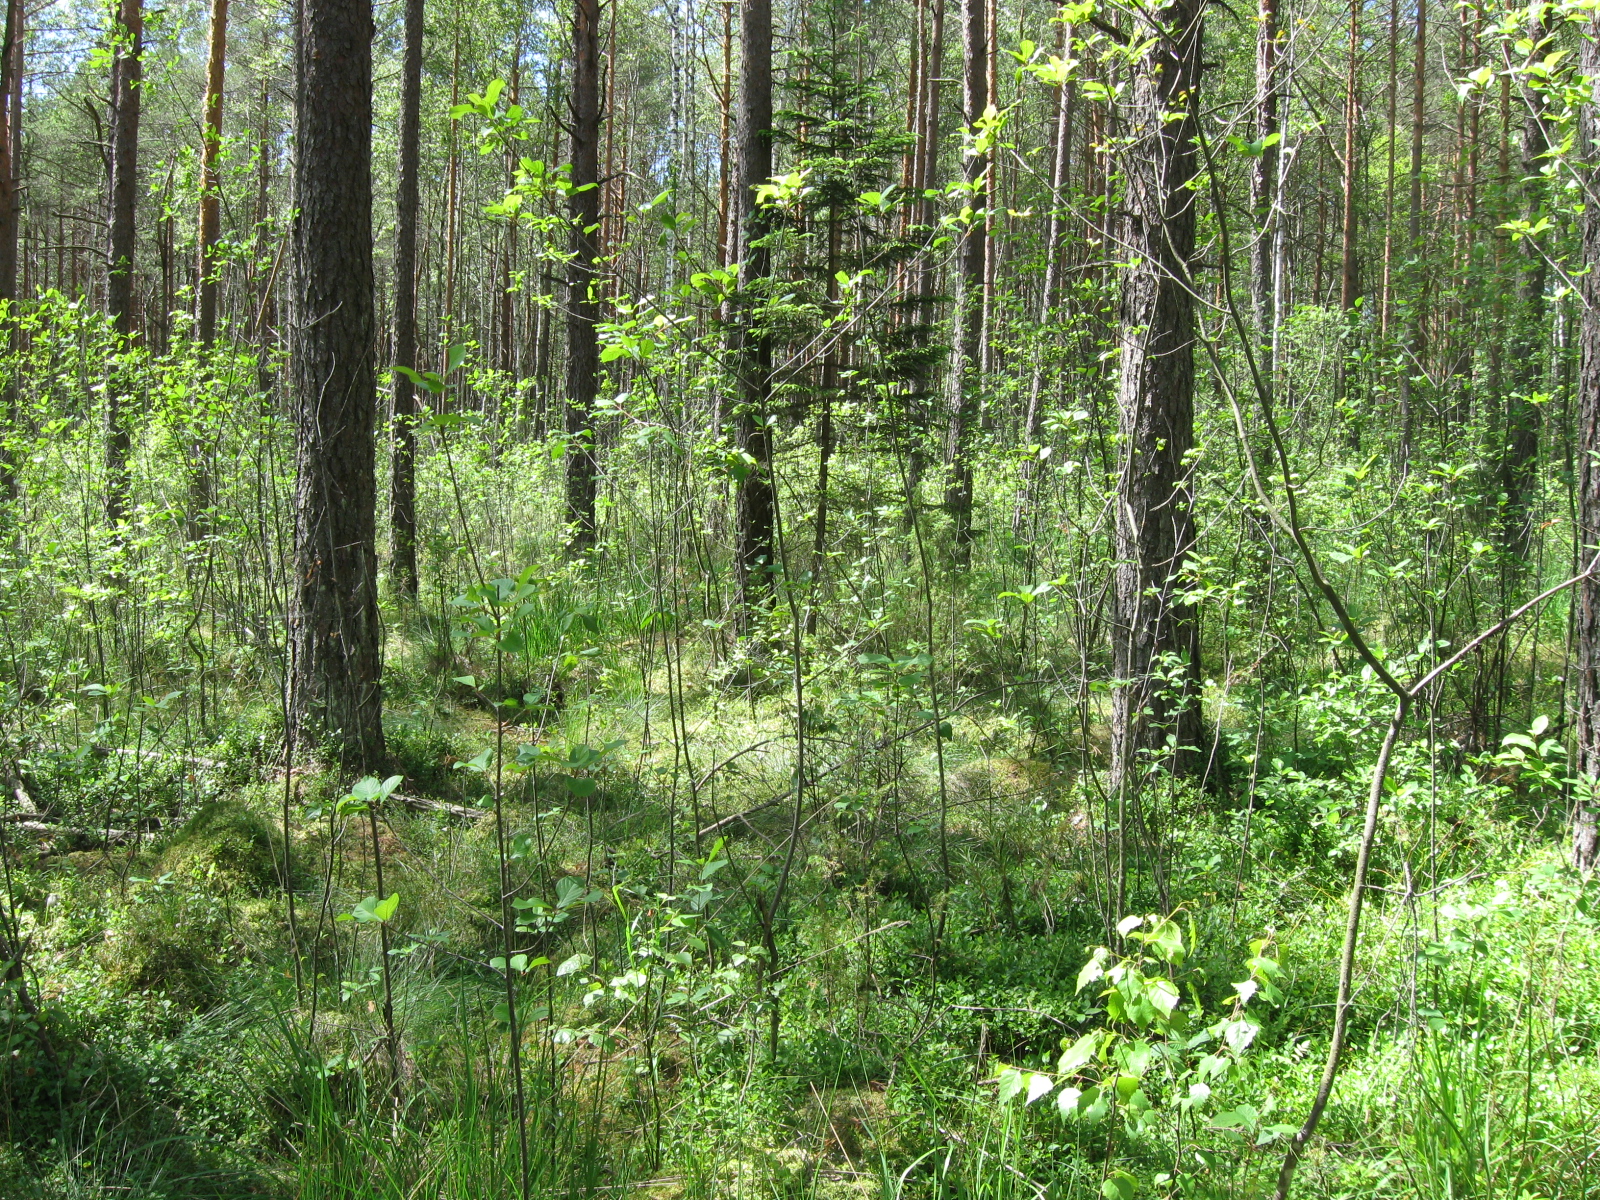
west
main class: Woodland
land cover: Pine dominated mixed woodland
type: mire and swamp forests
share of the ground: > 75 %
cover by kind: coniferous forest trees 55 %, broadleaved forest trees 30 %, herbaceous plants 15 %
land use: Forestry
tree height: > 5 m
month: June
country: LT
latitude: 53.9807
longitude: 24.2336
